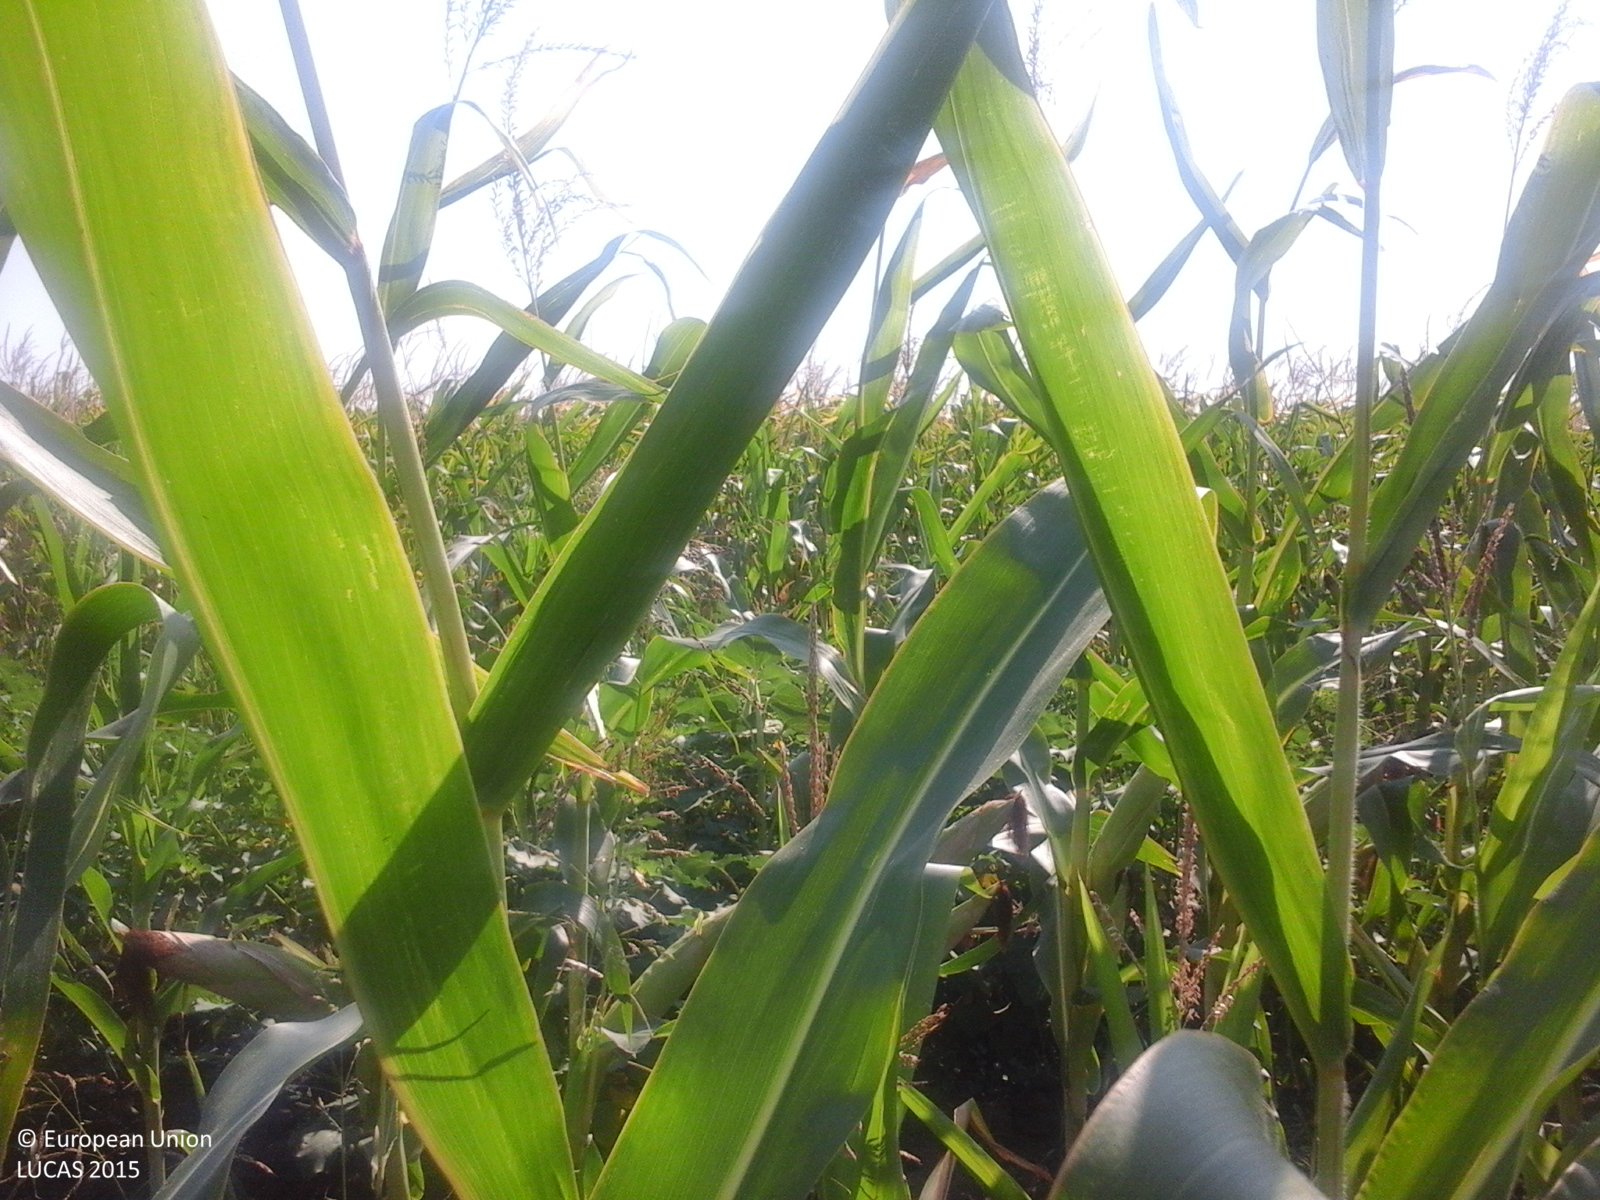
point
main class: Cropland
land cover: Maize
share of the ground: > 75 %
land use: Agriculture (excluding fallow land and kitchen gardens)
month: August
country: RO
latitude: 45.7468
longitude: 27.5753
